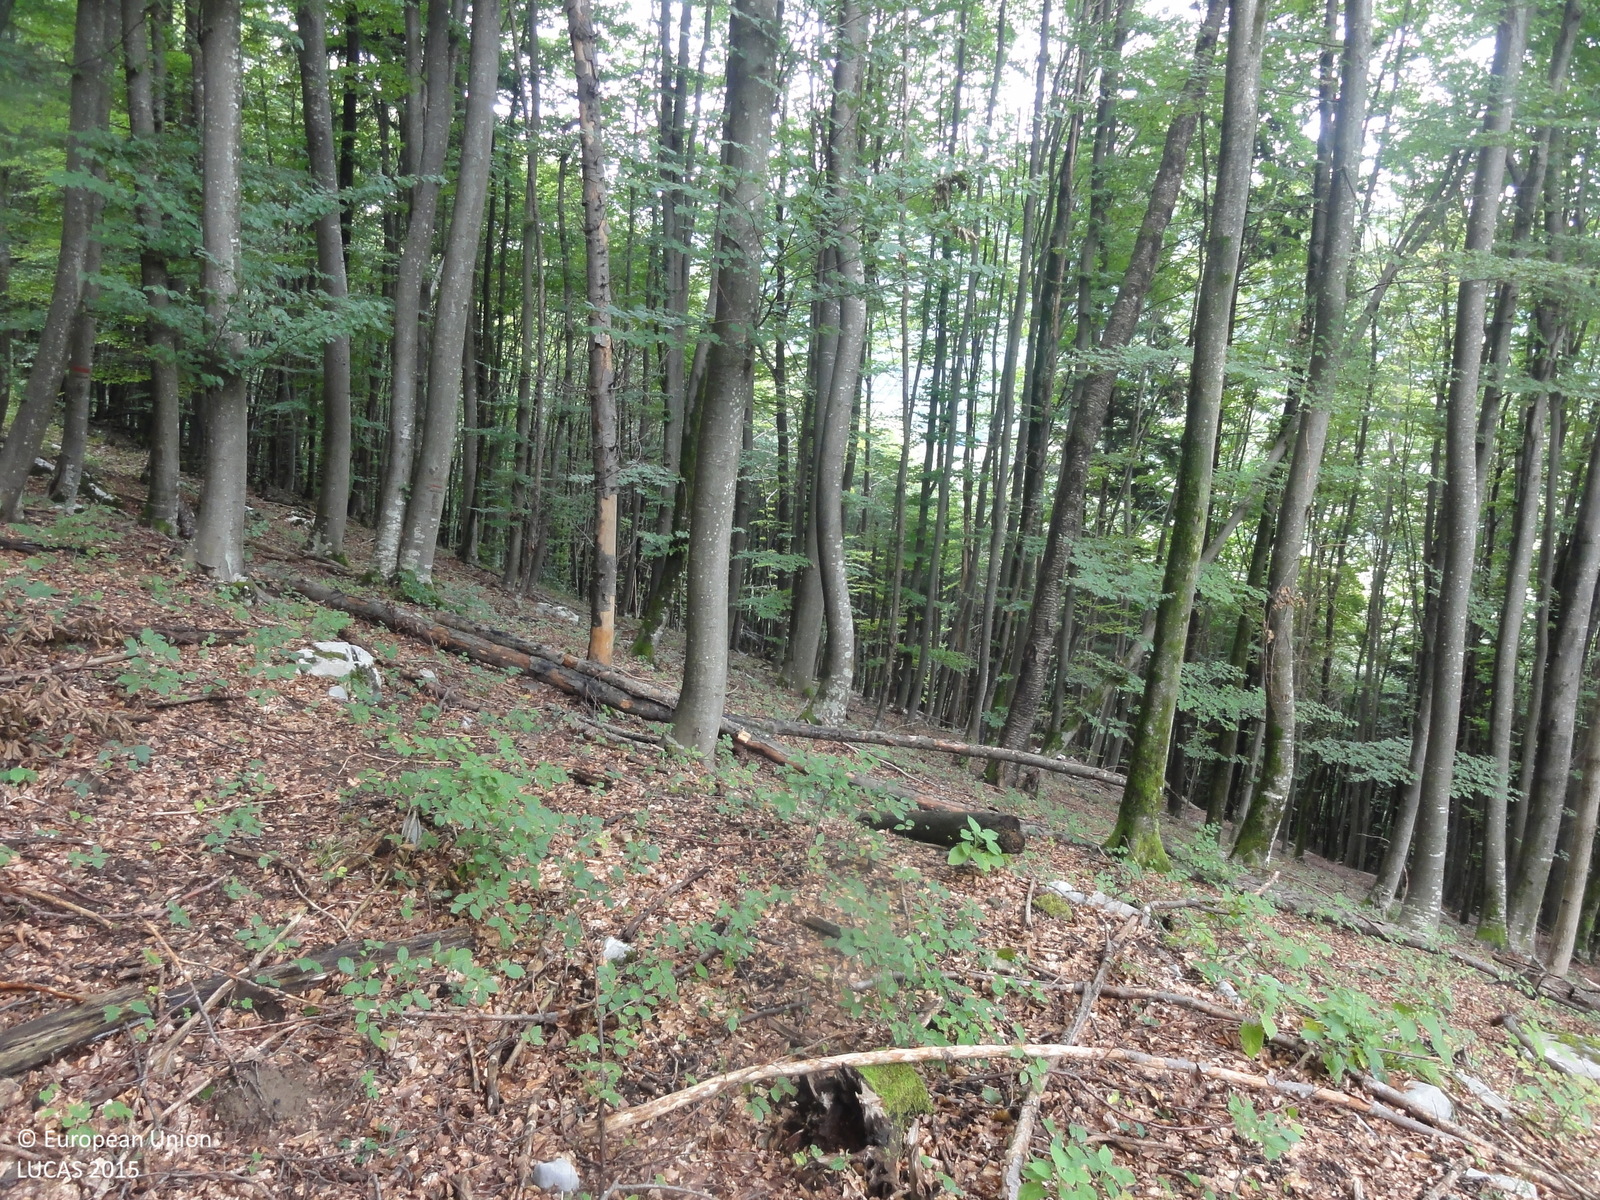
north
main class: Woodland
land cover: Broadleaved woodland
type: beech forest
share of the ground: > 75 %
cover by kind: broadleaved forest trees 95 %, shrubs 5 %
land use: Forestry
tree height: > 5 m
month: August
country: SI
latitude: 45.7640
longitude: 15.0237
